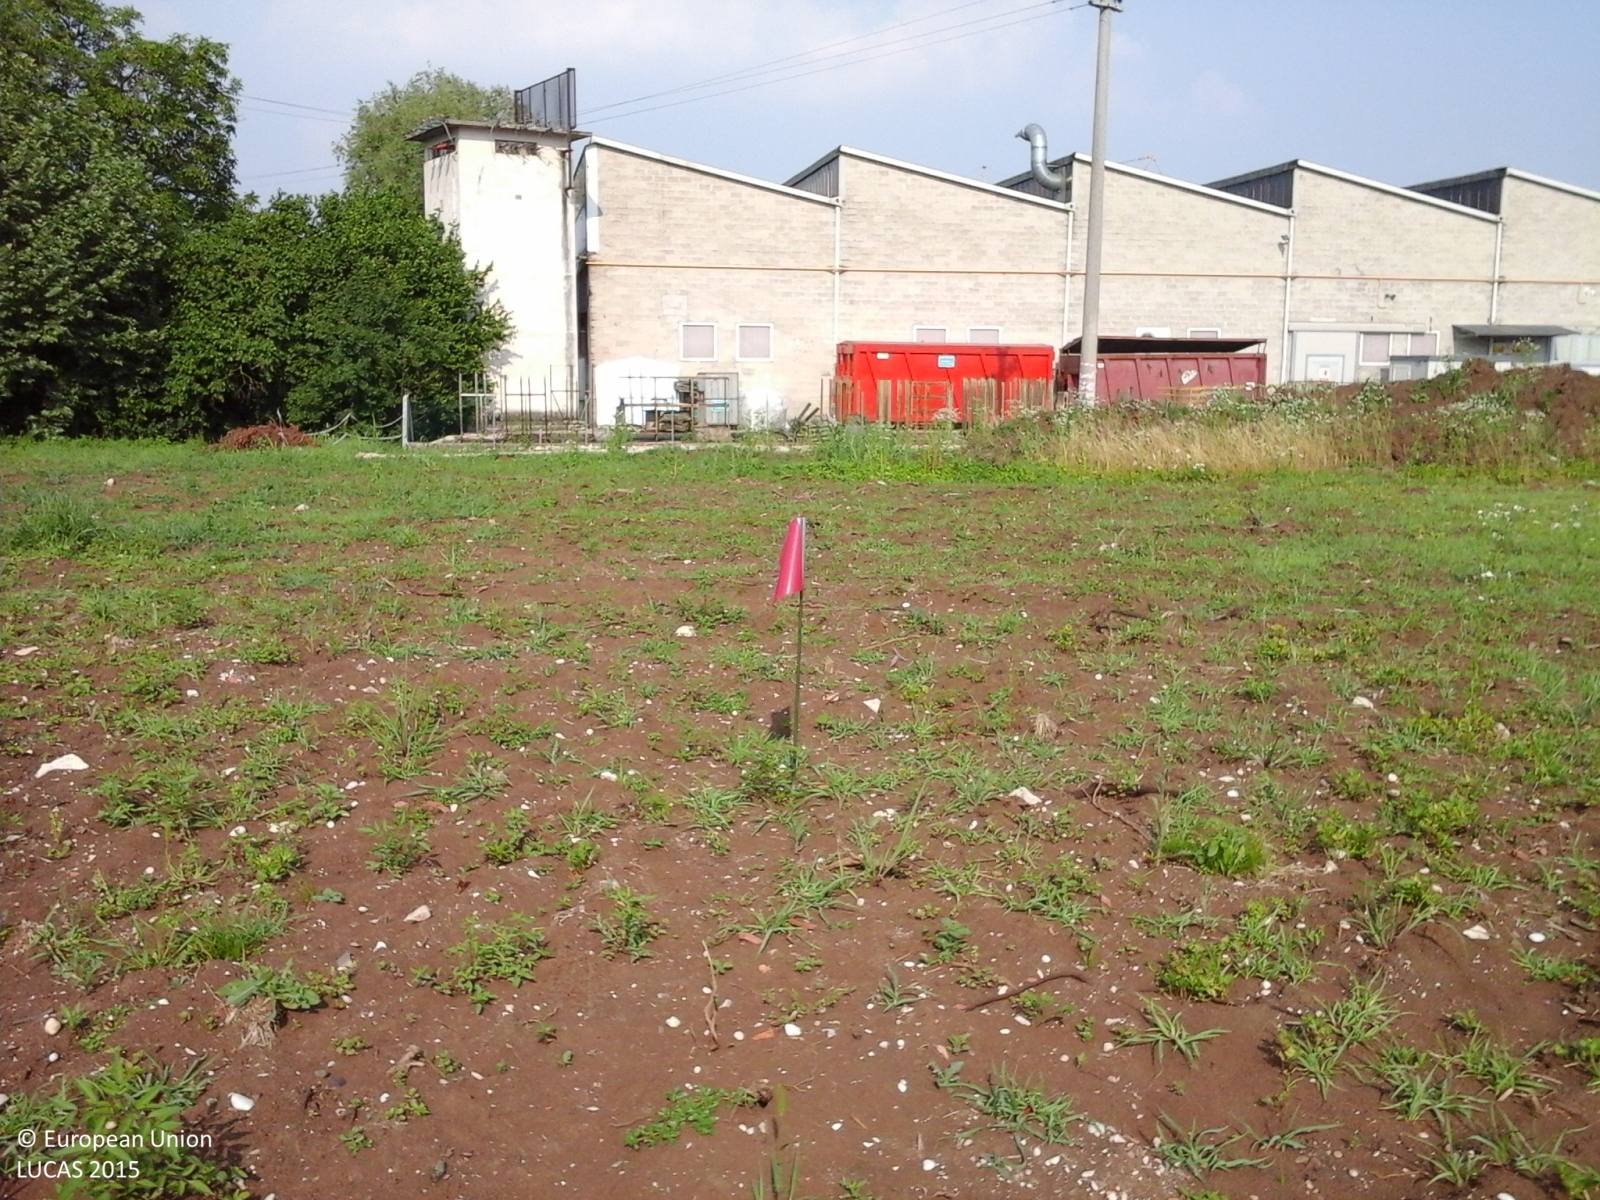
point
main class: Grassland
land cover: Spontaneously vegetated surfaces
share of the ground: 25 - 50 %
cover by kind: consolidated bare surface 60 %, herbaceous plants 40 %
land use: Fallow land
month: June
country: IT
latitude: 45.7261
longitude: 11.6294
